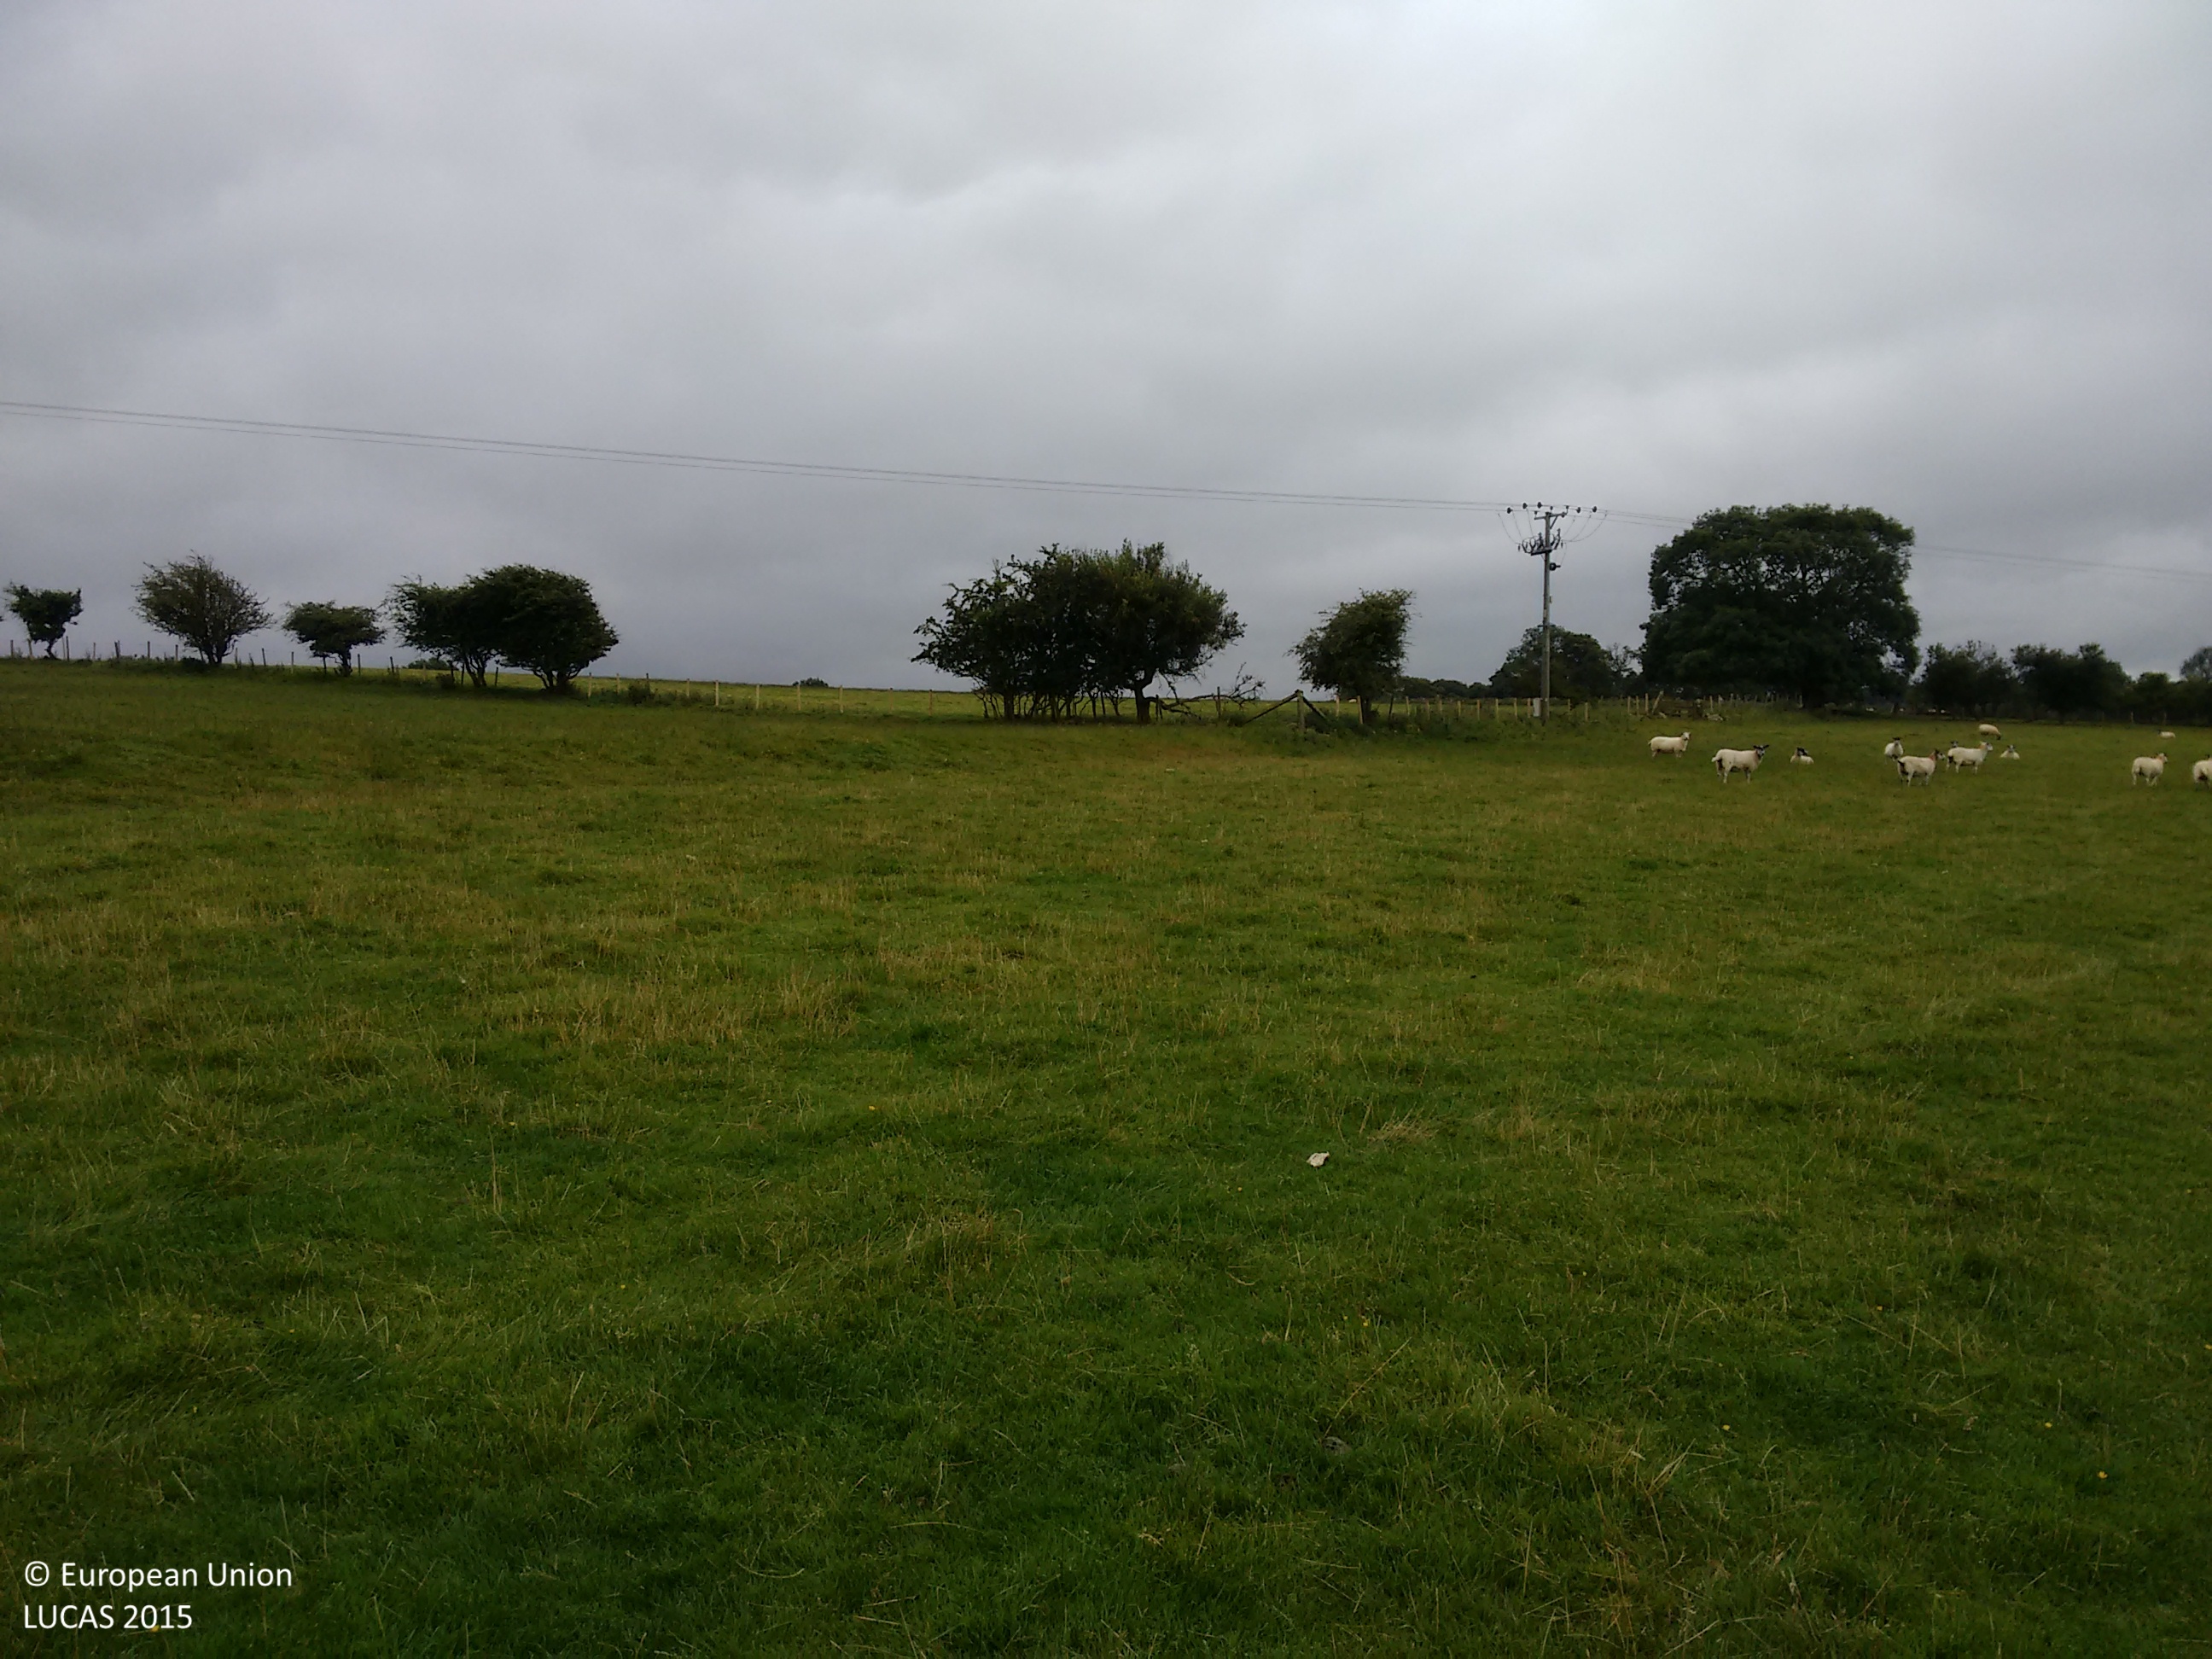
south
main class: Grassland
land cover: Grassland without tree/shrub cover
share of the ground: > 75 %
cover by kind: herbaceous plants 100 %
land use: Agriculture (excluding fallow land and kitchen gardens)
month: August
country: GB
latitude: 54.6565
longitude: -3.4262
